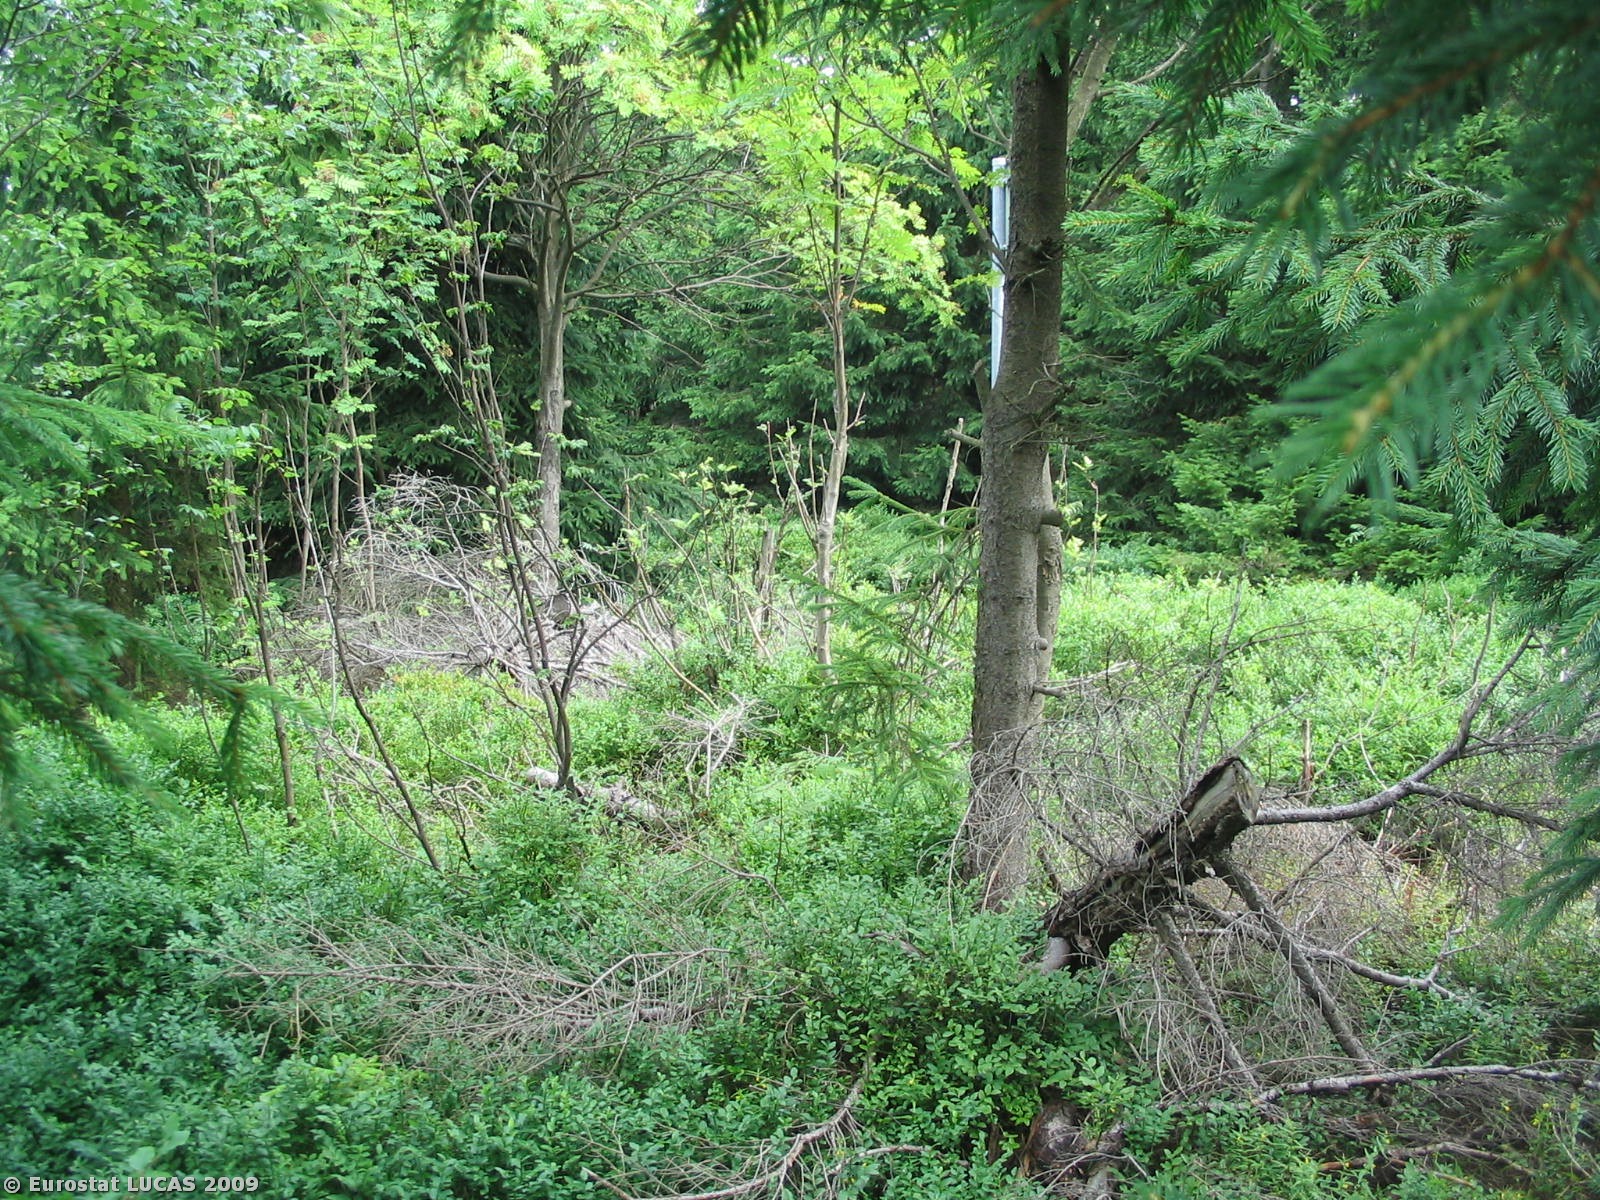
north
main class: Woodland
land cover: Mixed woodland
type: mountainous beech forest
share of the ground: > 75 %
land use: Forestry
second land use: Nature reserves
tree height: > 5 m
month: July
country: CZ
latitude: 50.7010
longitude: 15.8529
